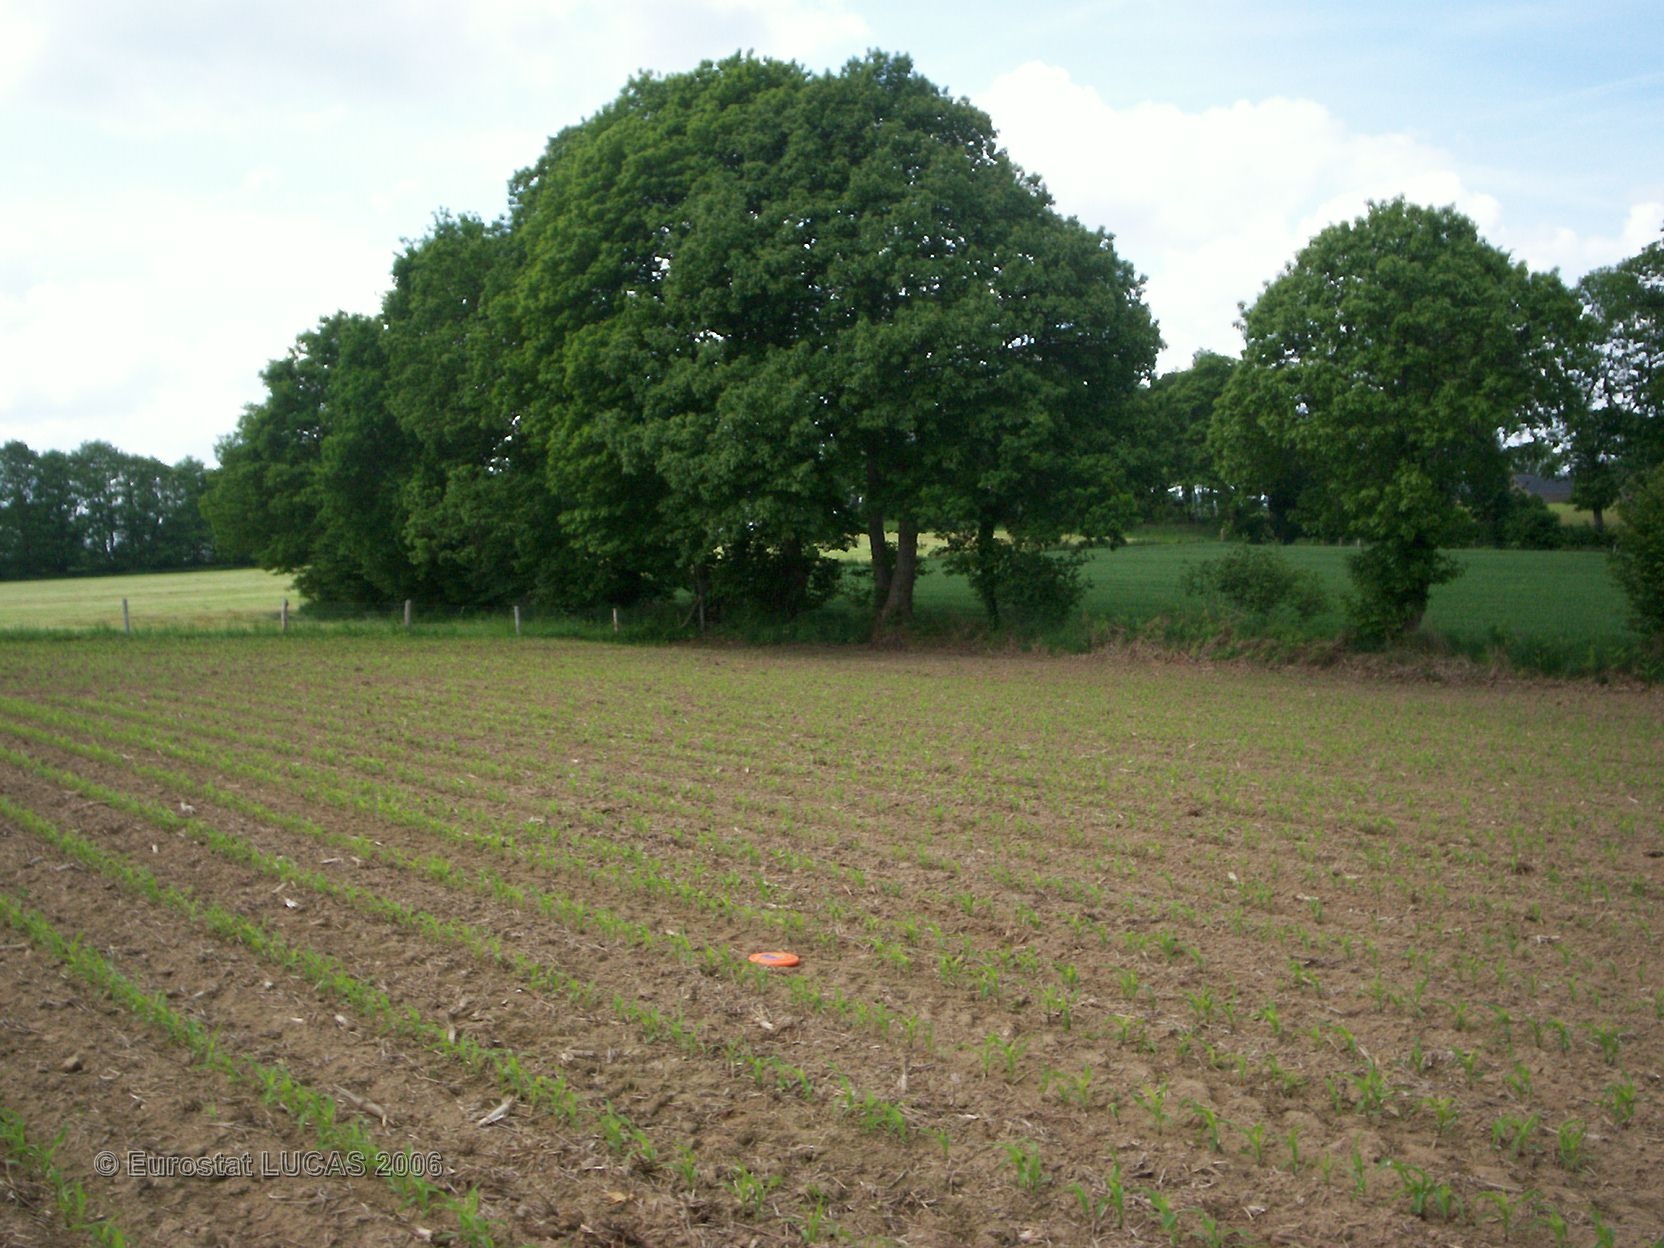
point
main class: Cropland
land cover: Maize
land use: Agriculture (excluding fallow land and kitchen gardens)
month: June
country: FR
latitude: 48.4476
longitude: -1.2241
